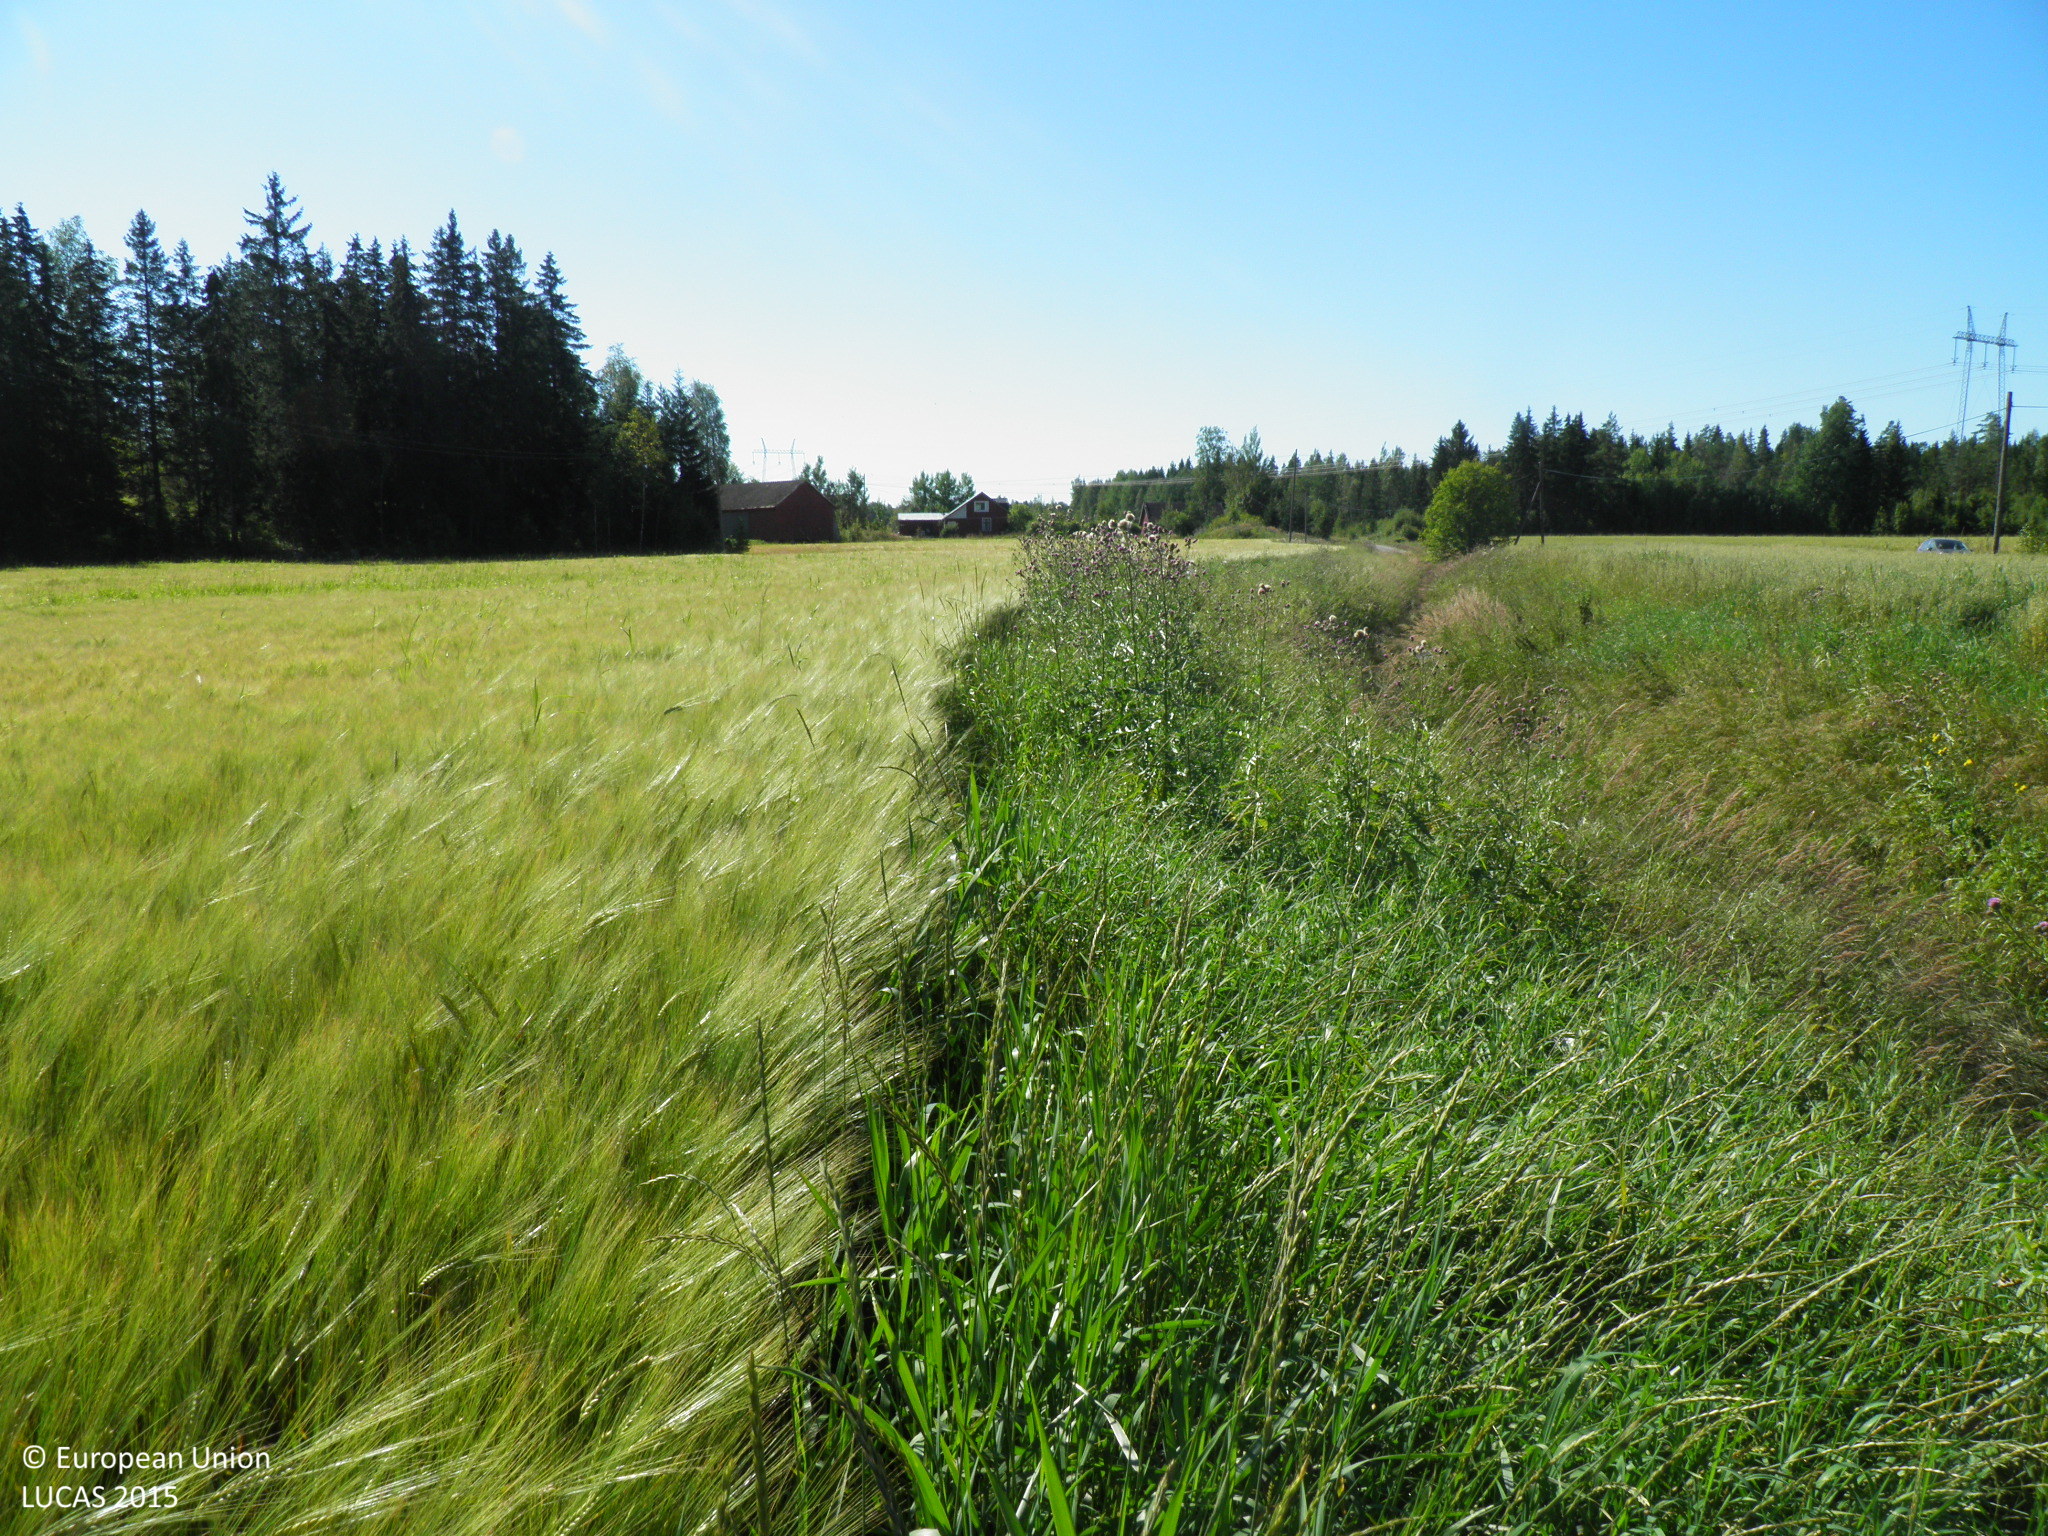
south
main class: Cropland
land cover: Barley
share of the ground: > 75 %
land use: Agriculture (excluding fallow land and kitchen gardens)
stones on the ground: < 10 %
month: August
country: FI
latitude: 60.7631
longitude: 21.9731
